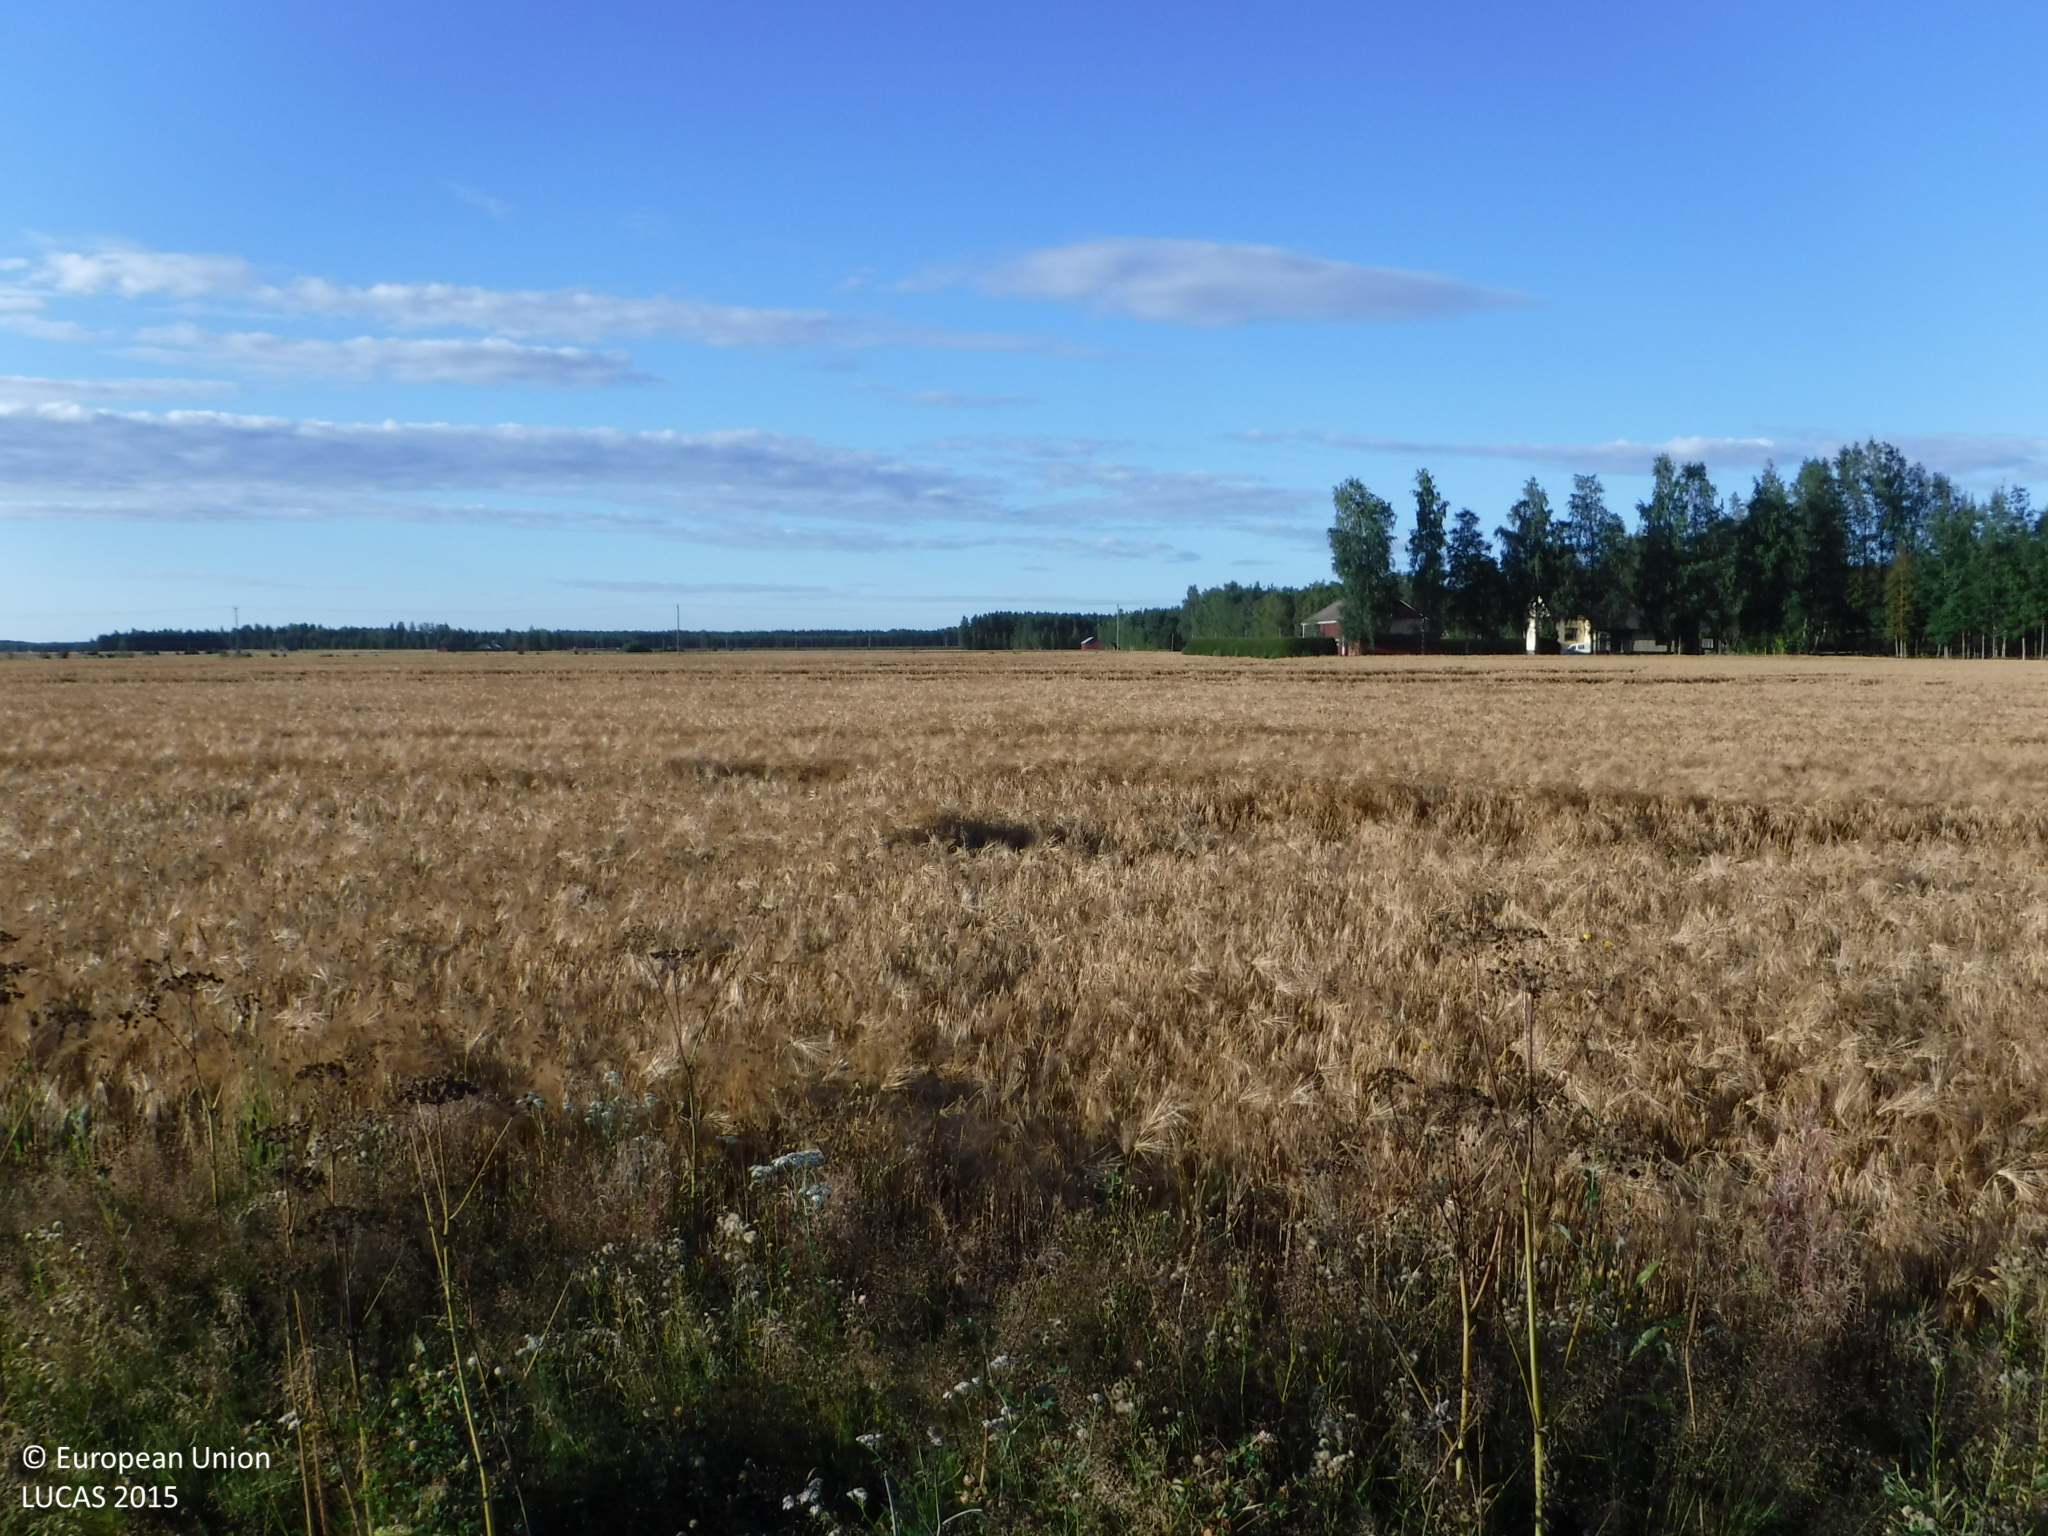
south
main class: Cropland
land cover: Barley
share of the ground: > 75 %
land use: Agriculture (excluding fallow land and kitchen gardens)
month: August
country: FI
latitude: 61.2910
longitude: 22.2096
